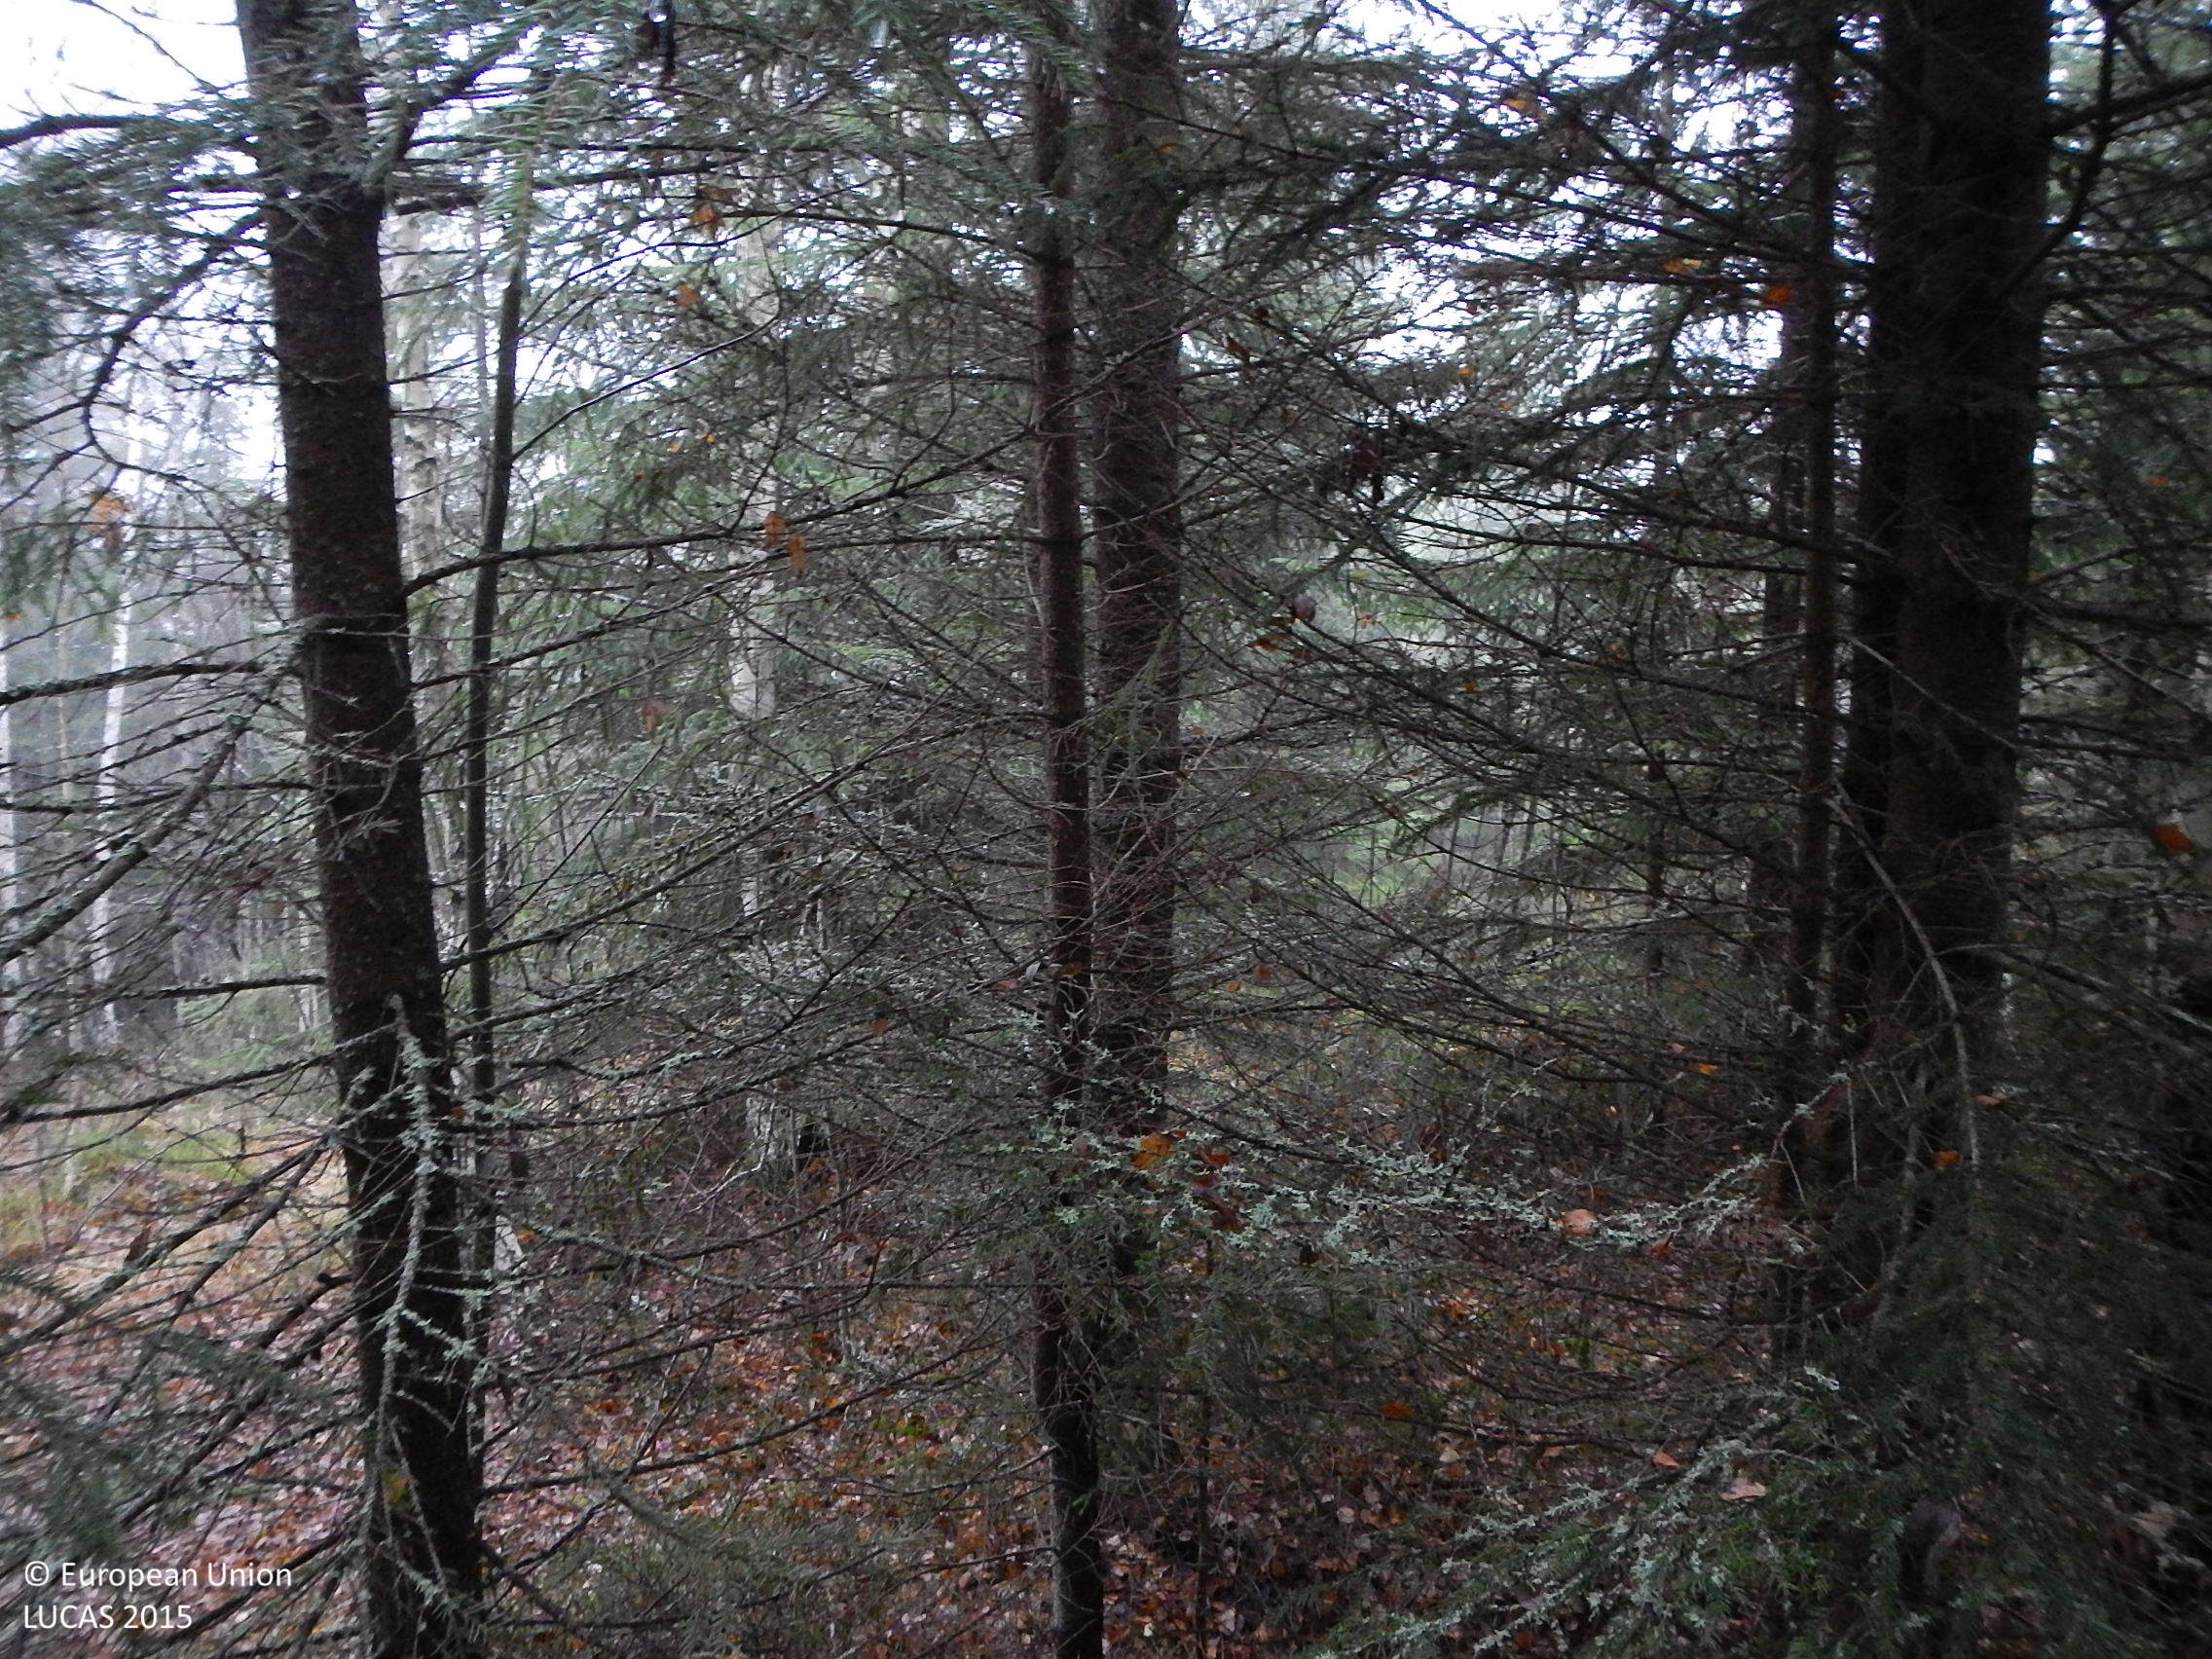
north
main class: Woodland
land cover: Spruce dominated mixed woodland
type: boreal forest
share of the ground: > 75 %
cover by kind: coniferous forest trees 50 %, broadleaved forest trees 30 %, shrubs 10 %, herbaceous plants 5 %, lichens and mosses 5 %
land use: Forestry
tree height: > 5 m
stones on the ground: < 10 %
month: November
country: SE
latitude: 61.3270
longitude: 16.6176
